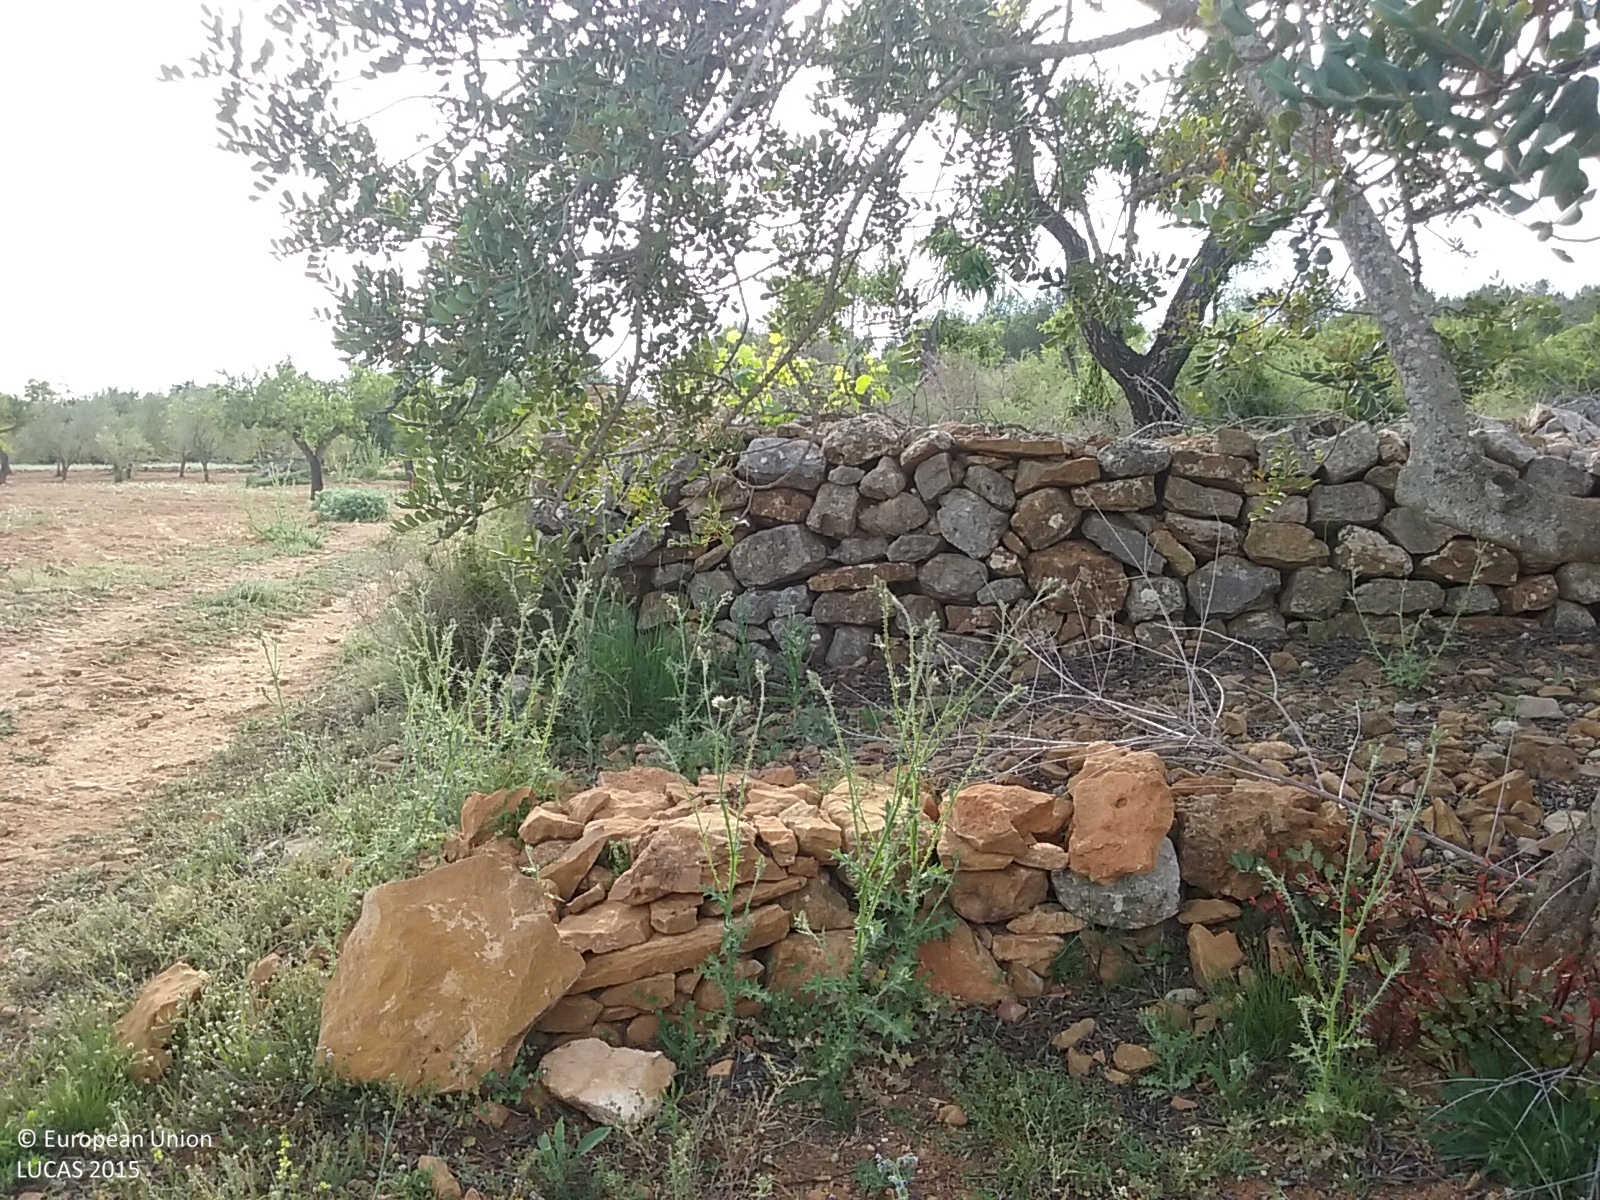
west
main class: Cropland
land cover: Olive groves
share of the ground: 25 - 50 %
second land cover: Grassland without tree/shrub cover
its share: 50 - 75 %
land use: Agriculture (excluding fallow land and kitchen gardens)
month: May
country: ES
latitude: 40.2175
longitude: 0.0680
